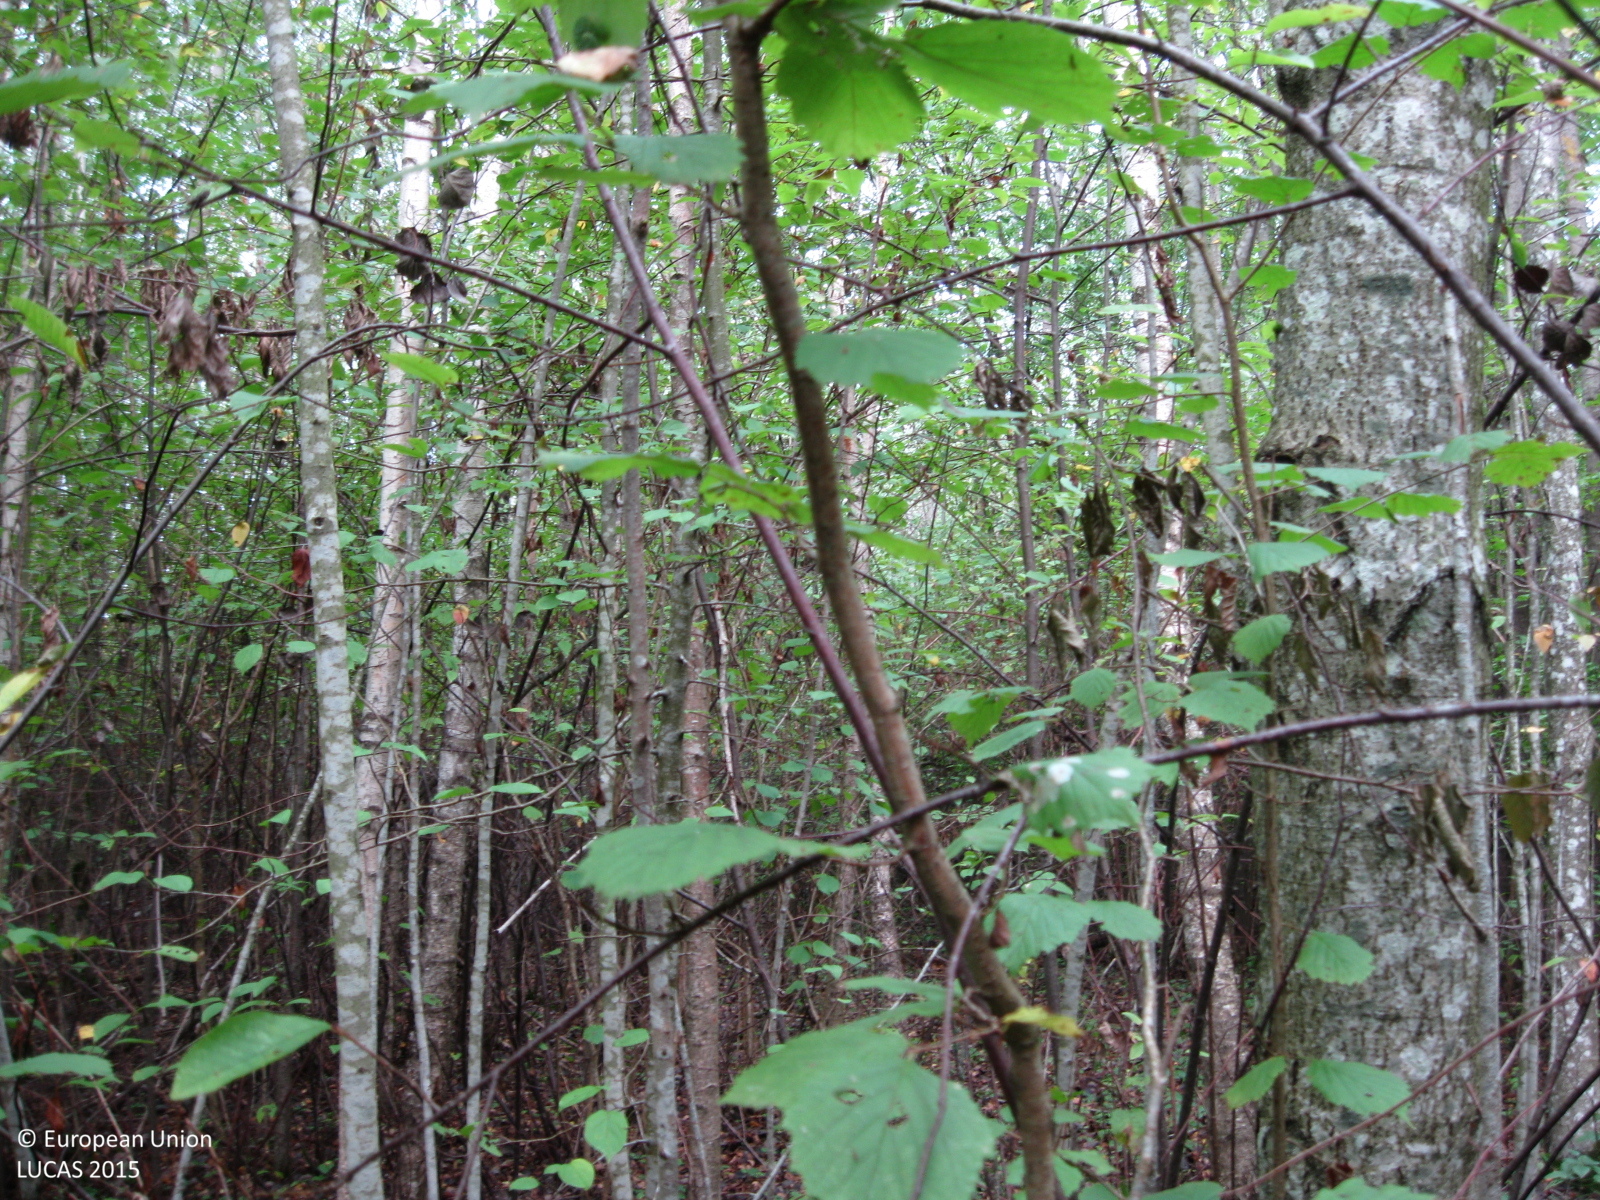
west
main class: Woodland
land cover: Broadleaved woodland
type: non-riverine alder, birch or aspen forest
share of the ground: > 75 %
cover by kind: broadleaved forest trees 85 %, unconsolidated bare surface 10 %, herbaceous plants 5 %
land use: Forestry
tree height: > 5 m
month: September
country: LT
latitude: 55.7587
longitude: 24.0324
